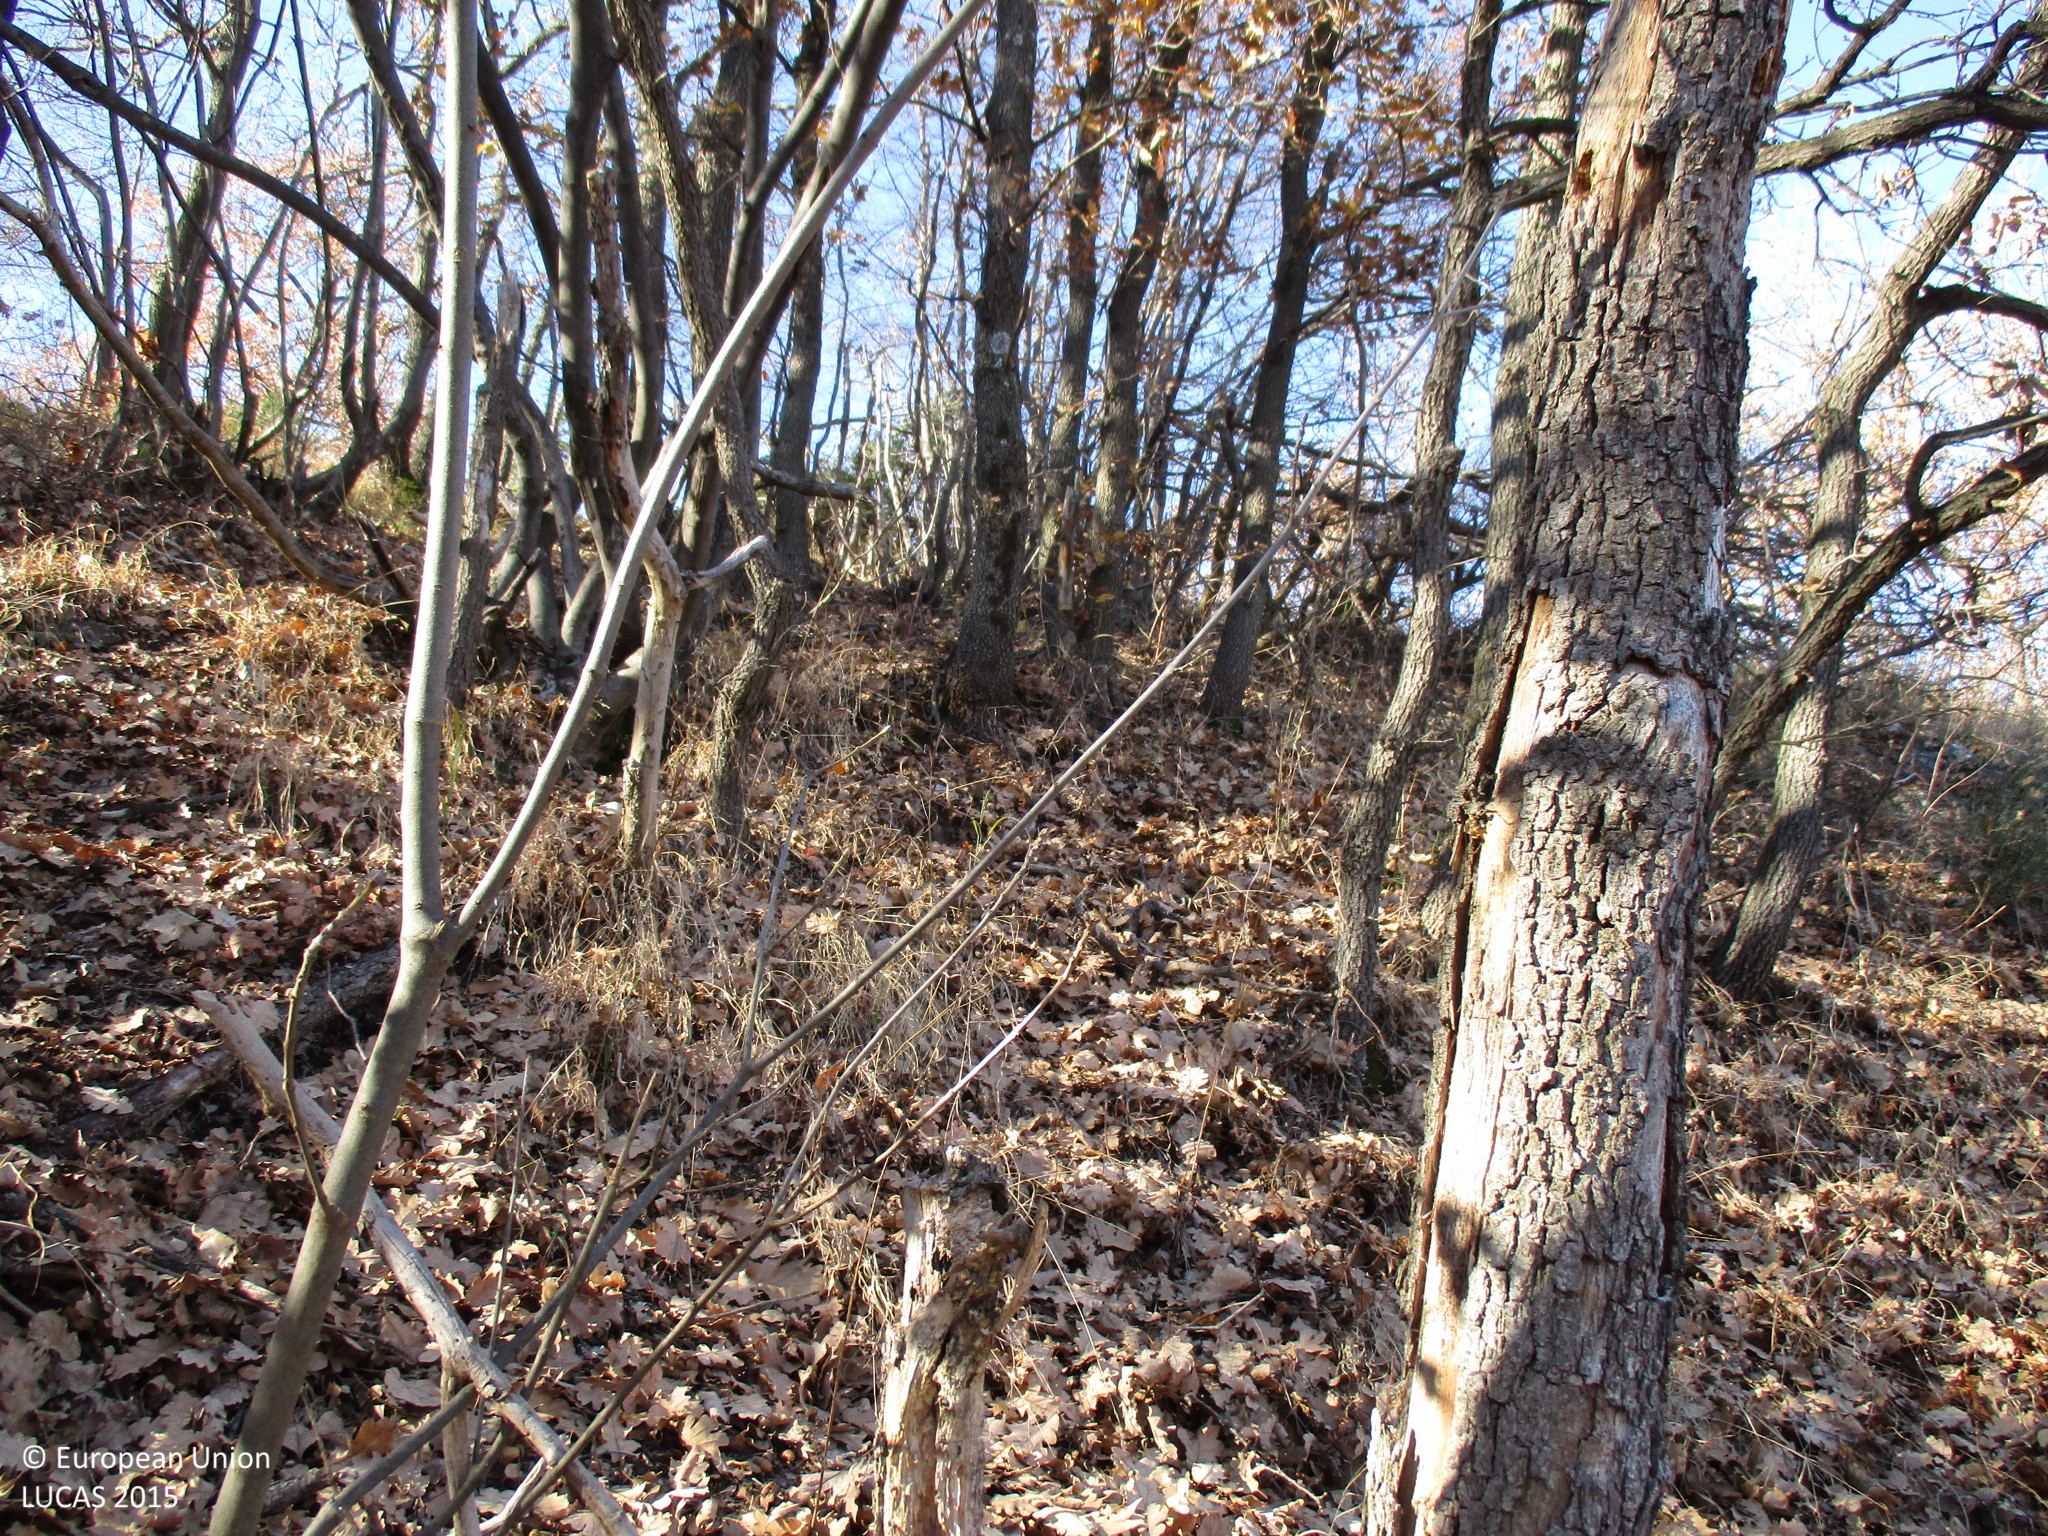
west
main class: Woodland
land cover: Broadleaved woodland
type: mesophytic deciduous forest
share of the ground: > 75 %
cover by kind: broadleaved forest trees 95 %, unconsolidated bare surface 5 %
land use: Forestry
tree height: > 5 m
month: December
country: BG
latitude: 42.0433
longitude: 24.6299
